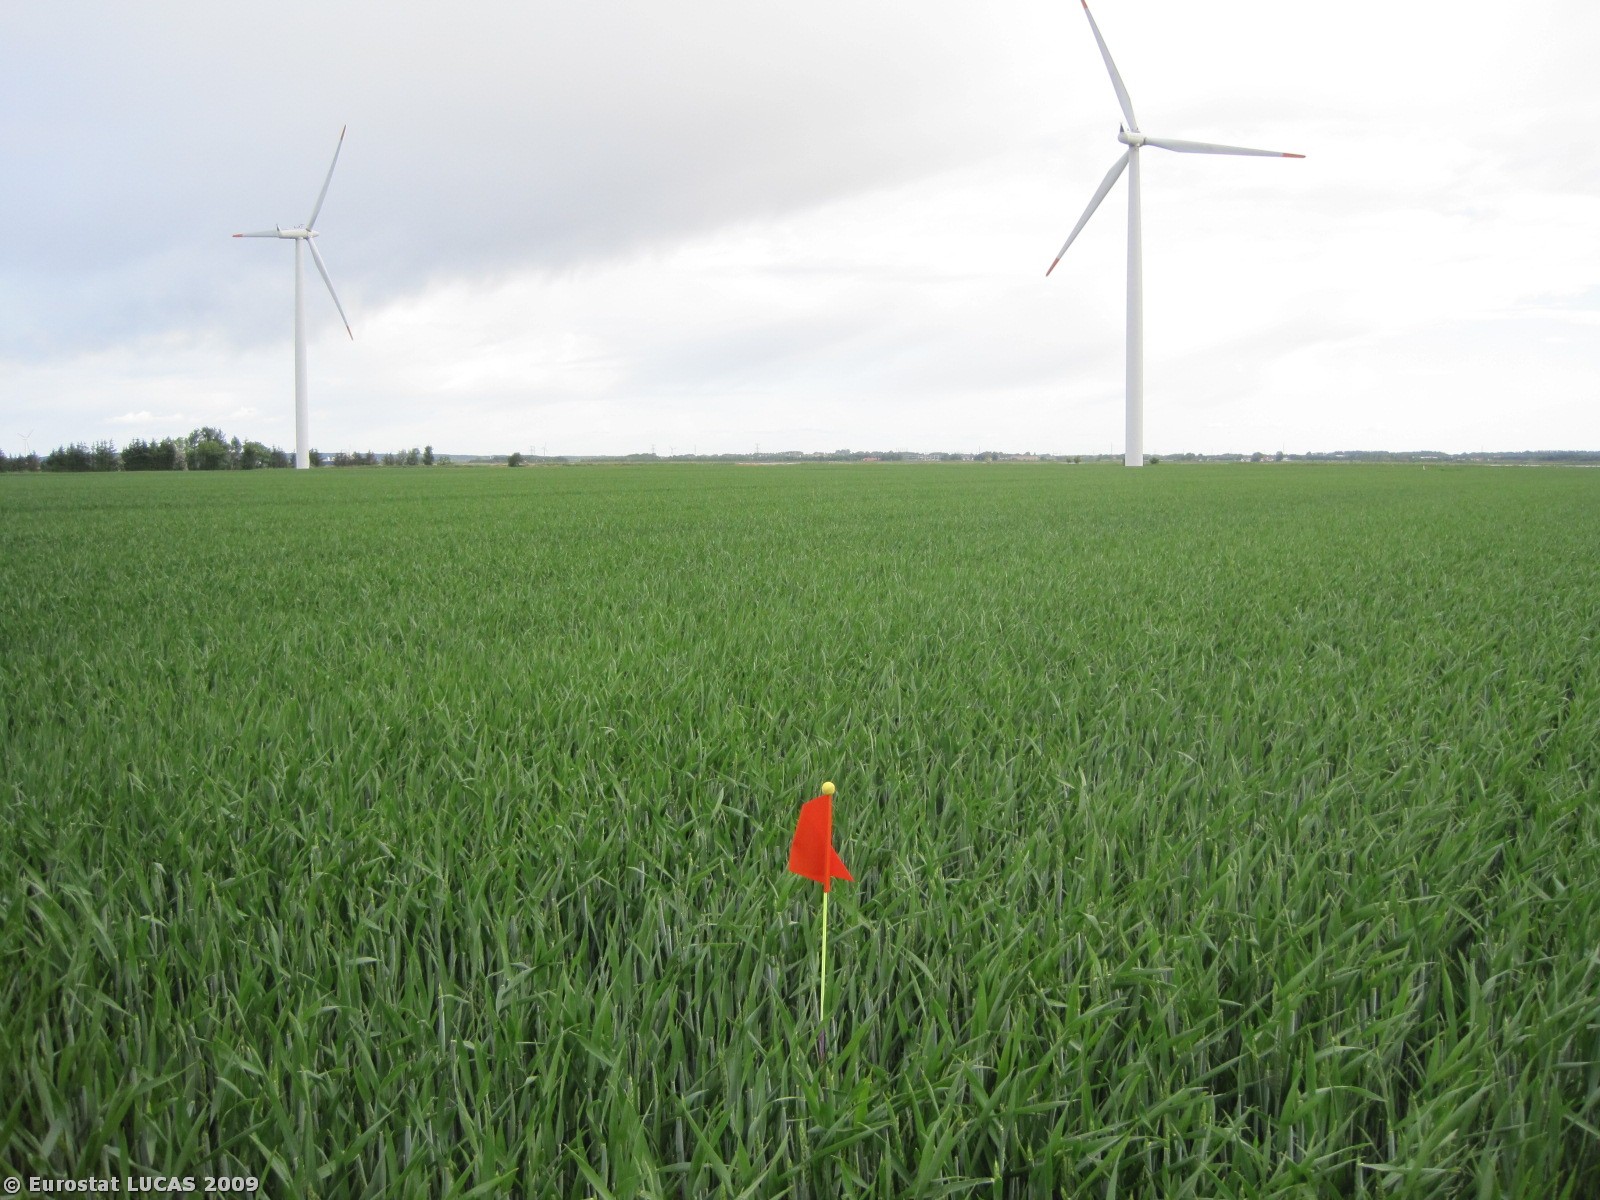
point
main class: Cropland
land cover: Common wheat
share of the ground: > 75 %
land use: Agriculture (excluding fallow land and kitchen gardens)
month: June
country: DK
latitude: 57.0326
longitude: 10.0823
